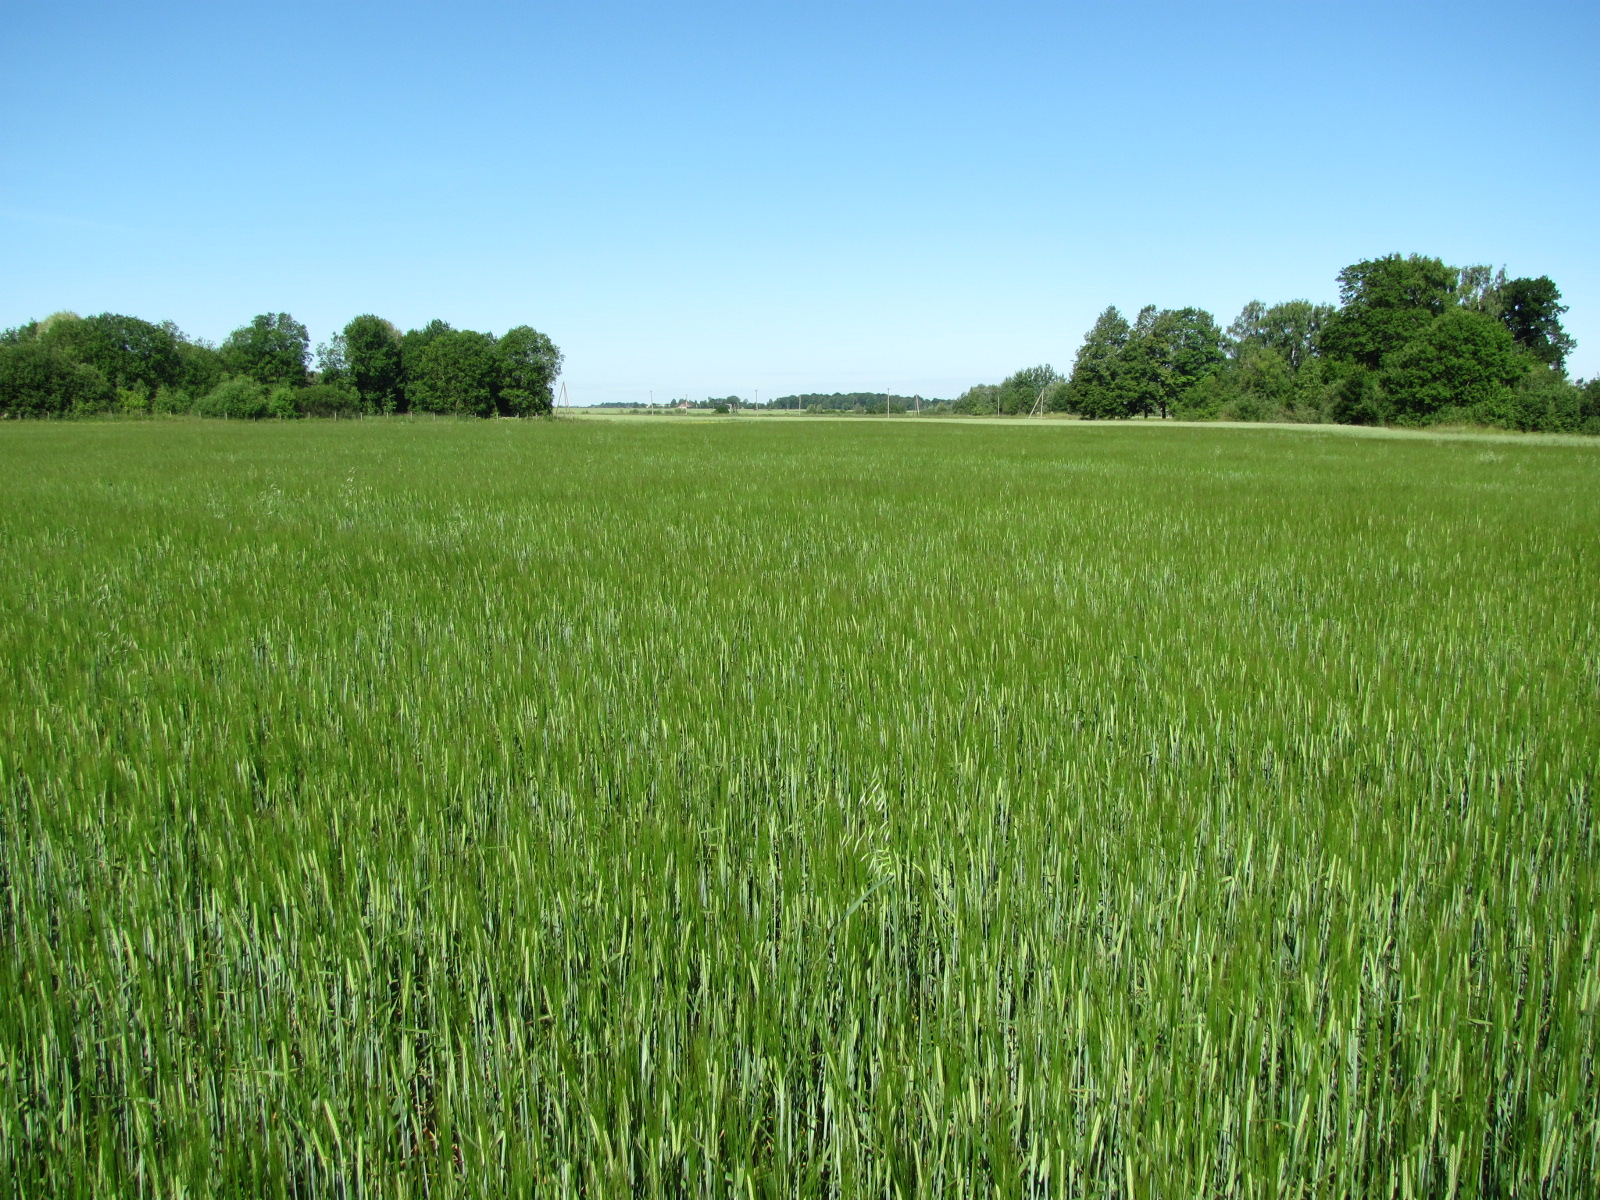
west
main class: Cropland
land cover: Barley
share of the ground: > 75 %
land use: Agriculture (excluding fallow land and kitchen gardens)
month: July
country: LV
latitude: 56.4895
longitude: 23.8710
